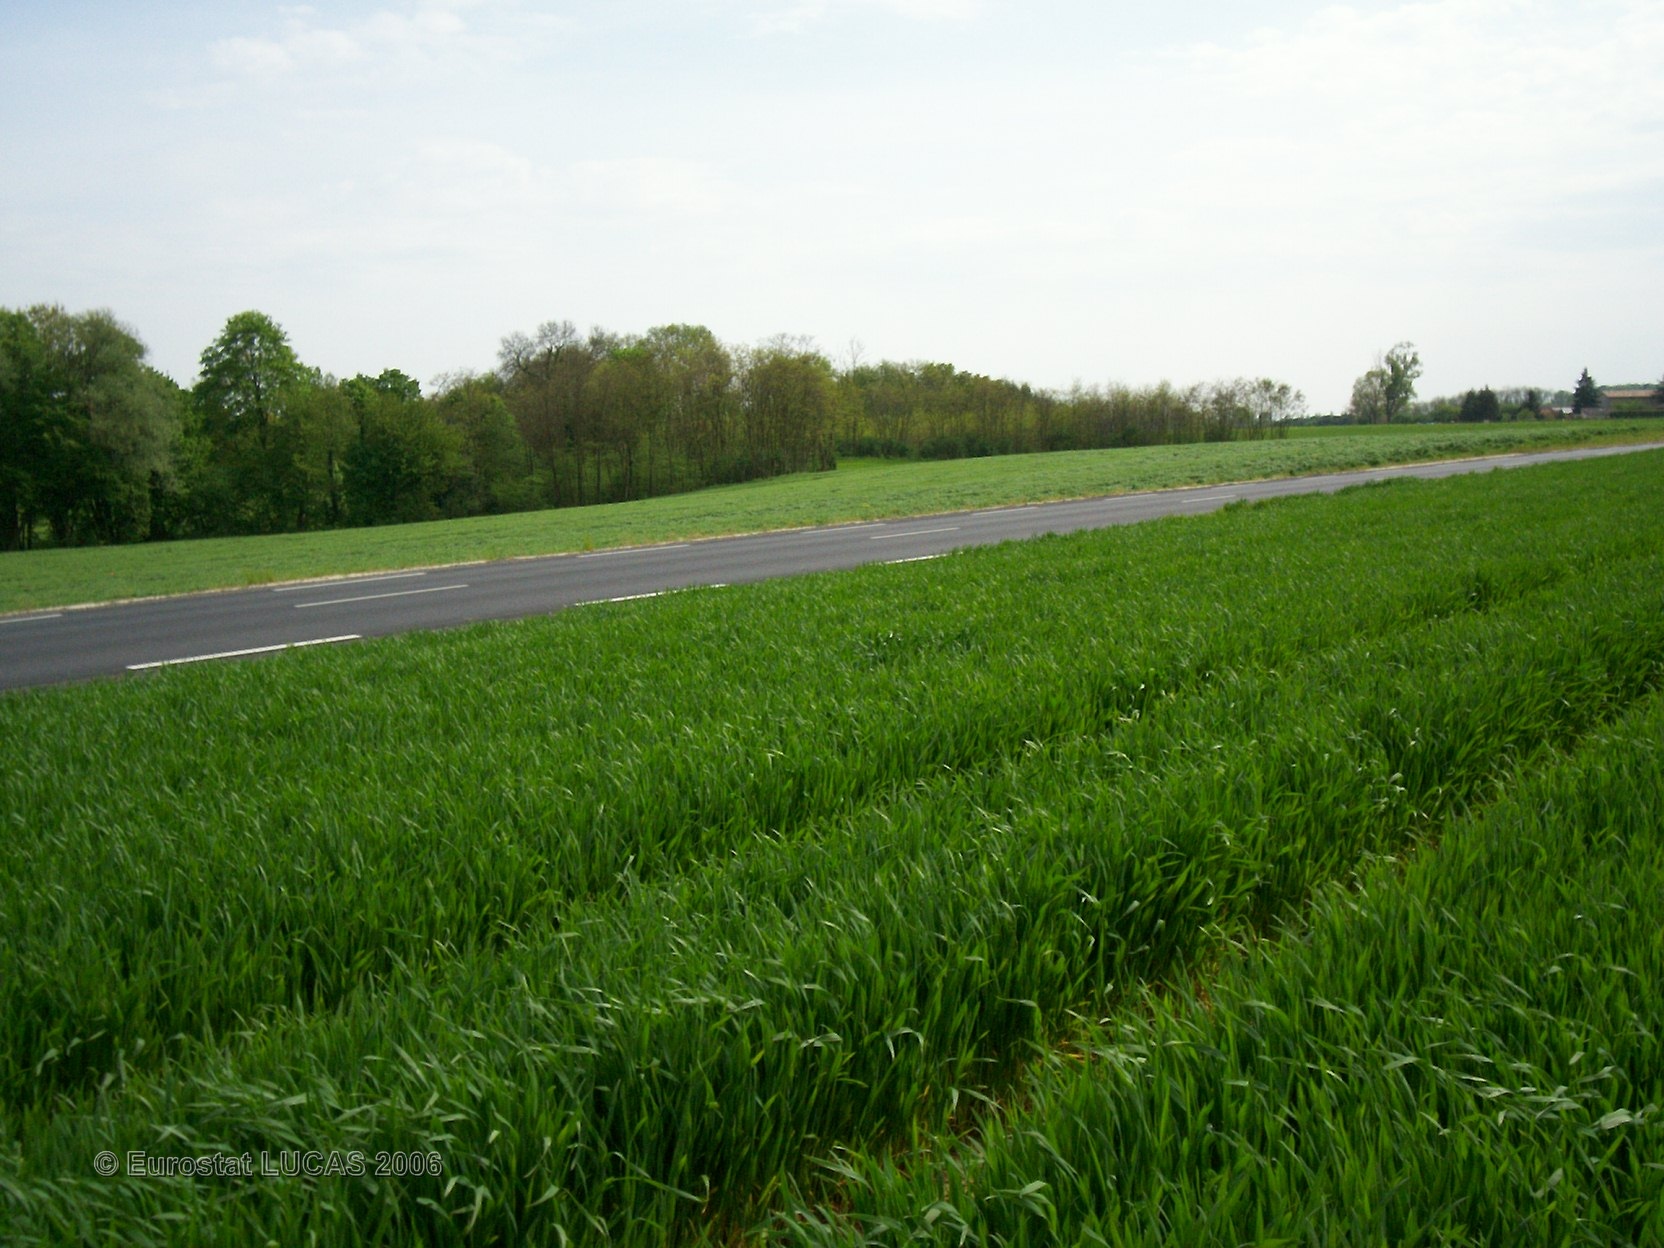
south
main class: Cropland
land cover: Common wheat
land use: Agriculture (excluding fallow land and kitchen gardens)
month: May
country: FR
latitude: 45.9901
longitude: 4.8002
